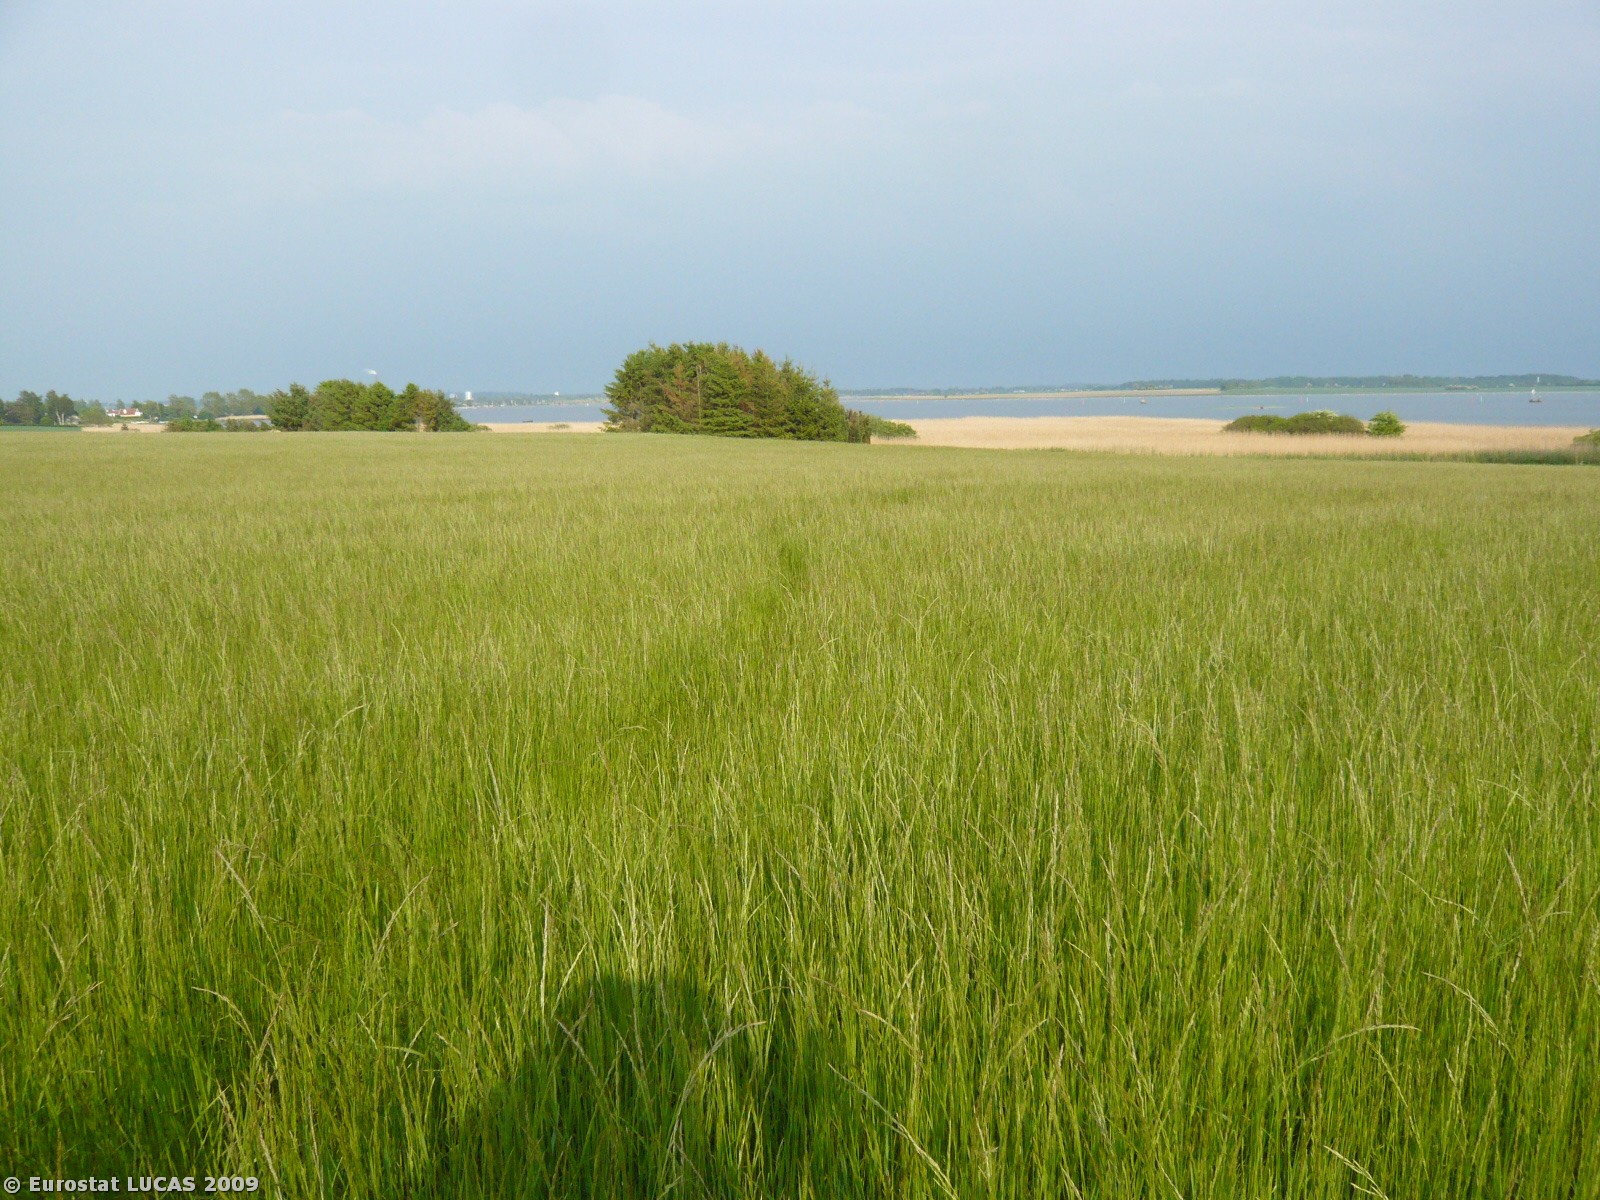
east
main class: Grassland
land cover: Grassland without tree/shrub cover
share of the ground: > 75 %
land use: Agriculture (excluding fallow land and kitchen gardens)
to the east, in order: Grassland without tree/shrub cover; Inland marshes
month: May
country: DK
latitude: 55.2059
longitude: 11.6801
